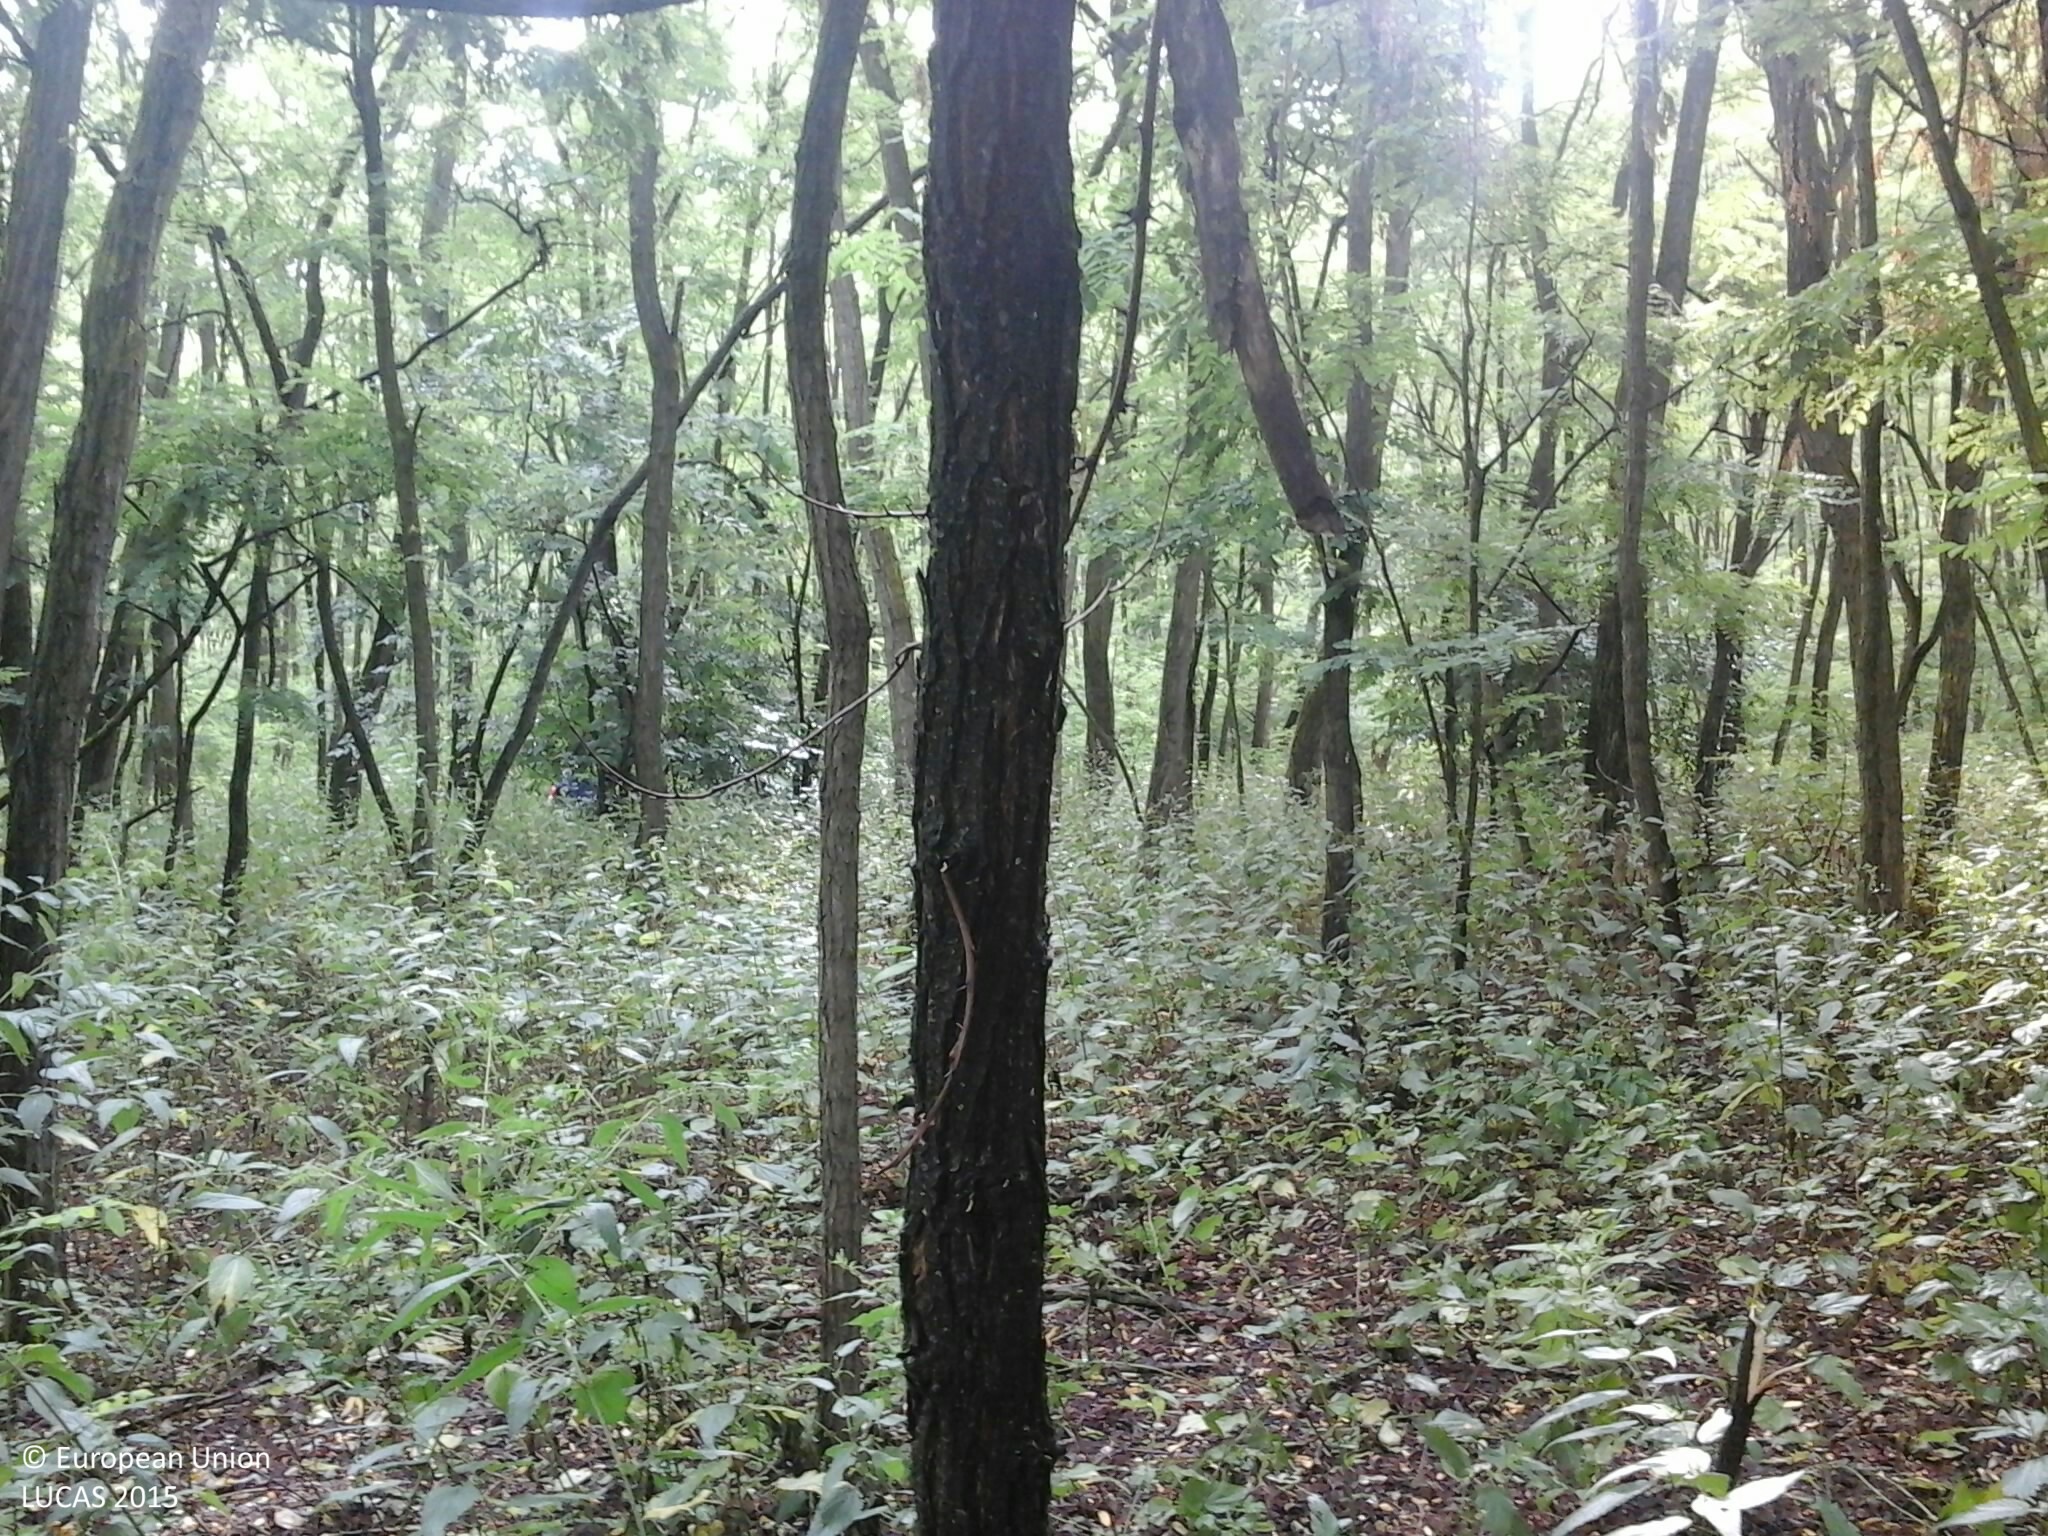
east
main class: Woodland
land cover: Broadleaved woodland
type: mesophytic deciduous forest
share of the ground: > 75 %
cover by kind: broadleaved forest trees 95 %, herbaceous plants 5 %
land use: Forestry
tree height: > 5 m
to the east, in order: Broadleaved woodland; Tracks; Broadleaved woodland; Tracks
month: July
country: HU
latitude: 47.7543
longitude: 21.9355
